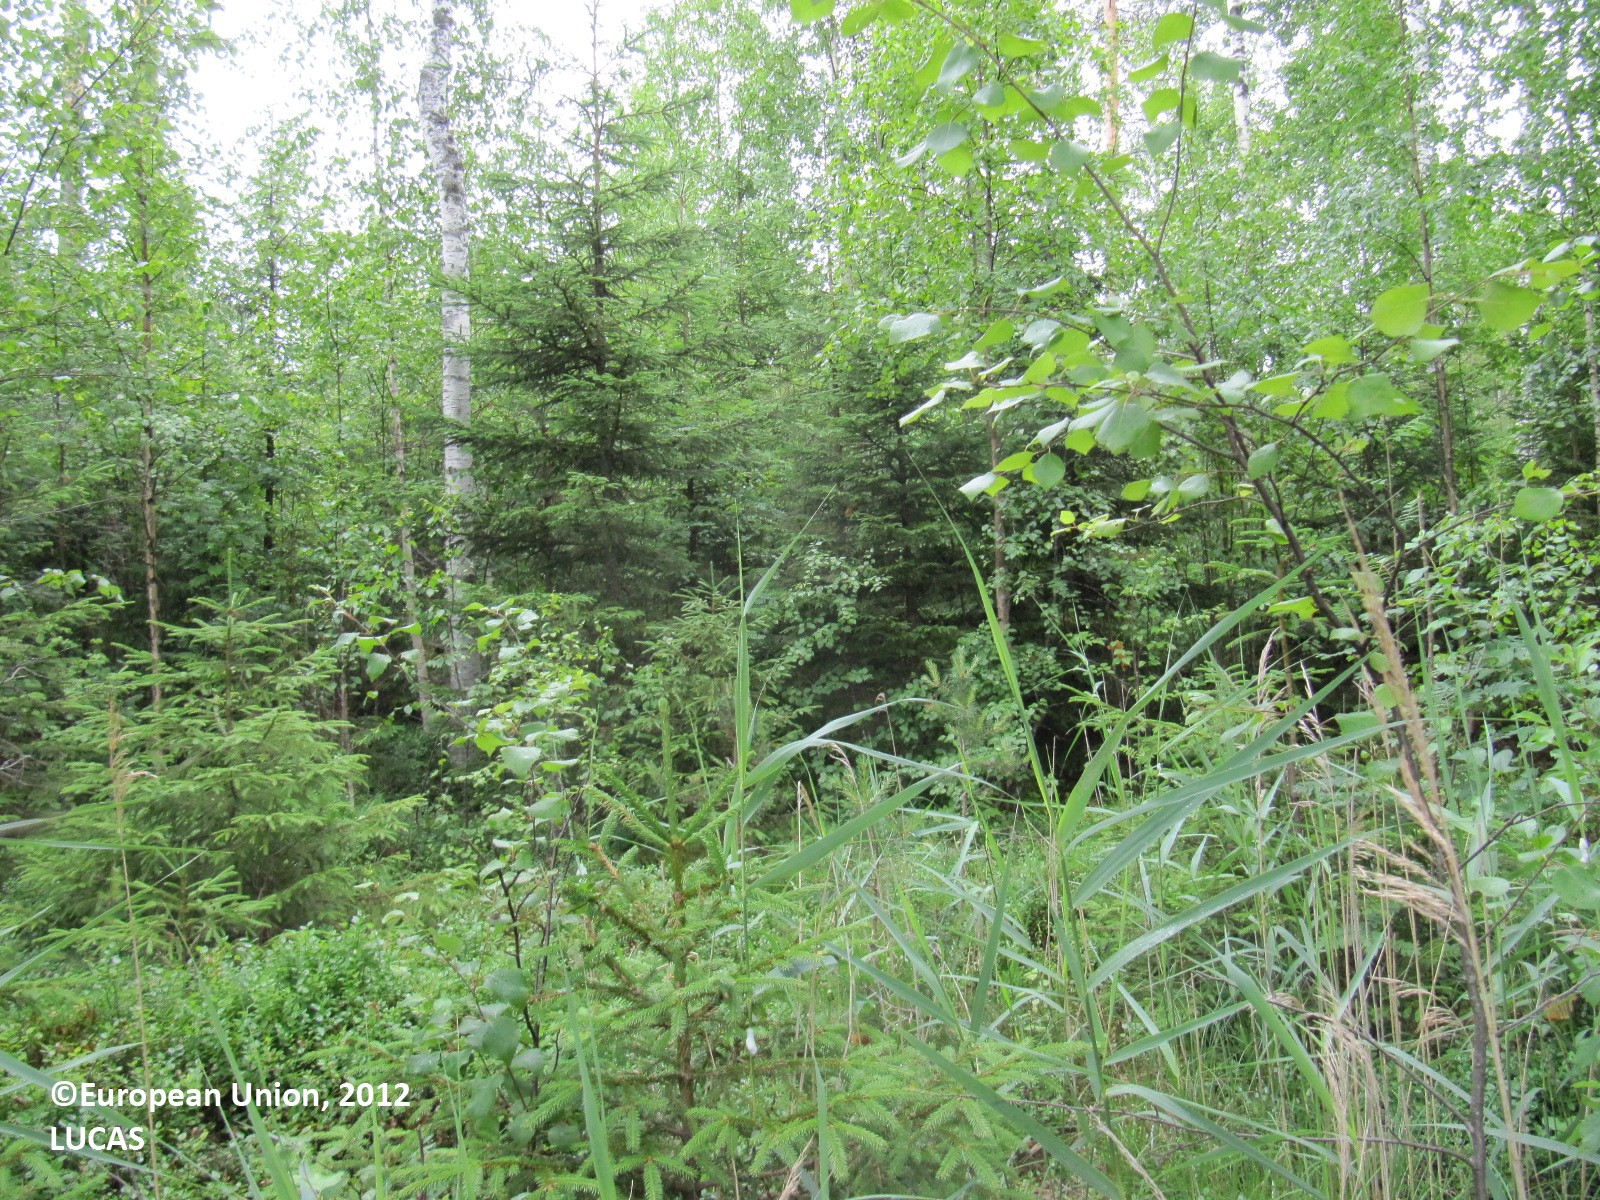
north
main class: Woodland
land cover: Other mixed woodland
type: boreal forest
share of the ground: > 75 %
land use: Forestry
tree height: > 5 m
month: July
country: FI
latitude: 60.9273
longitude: 24.1727
